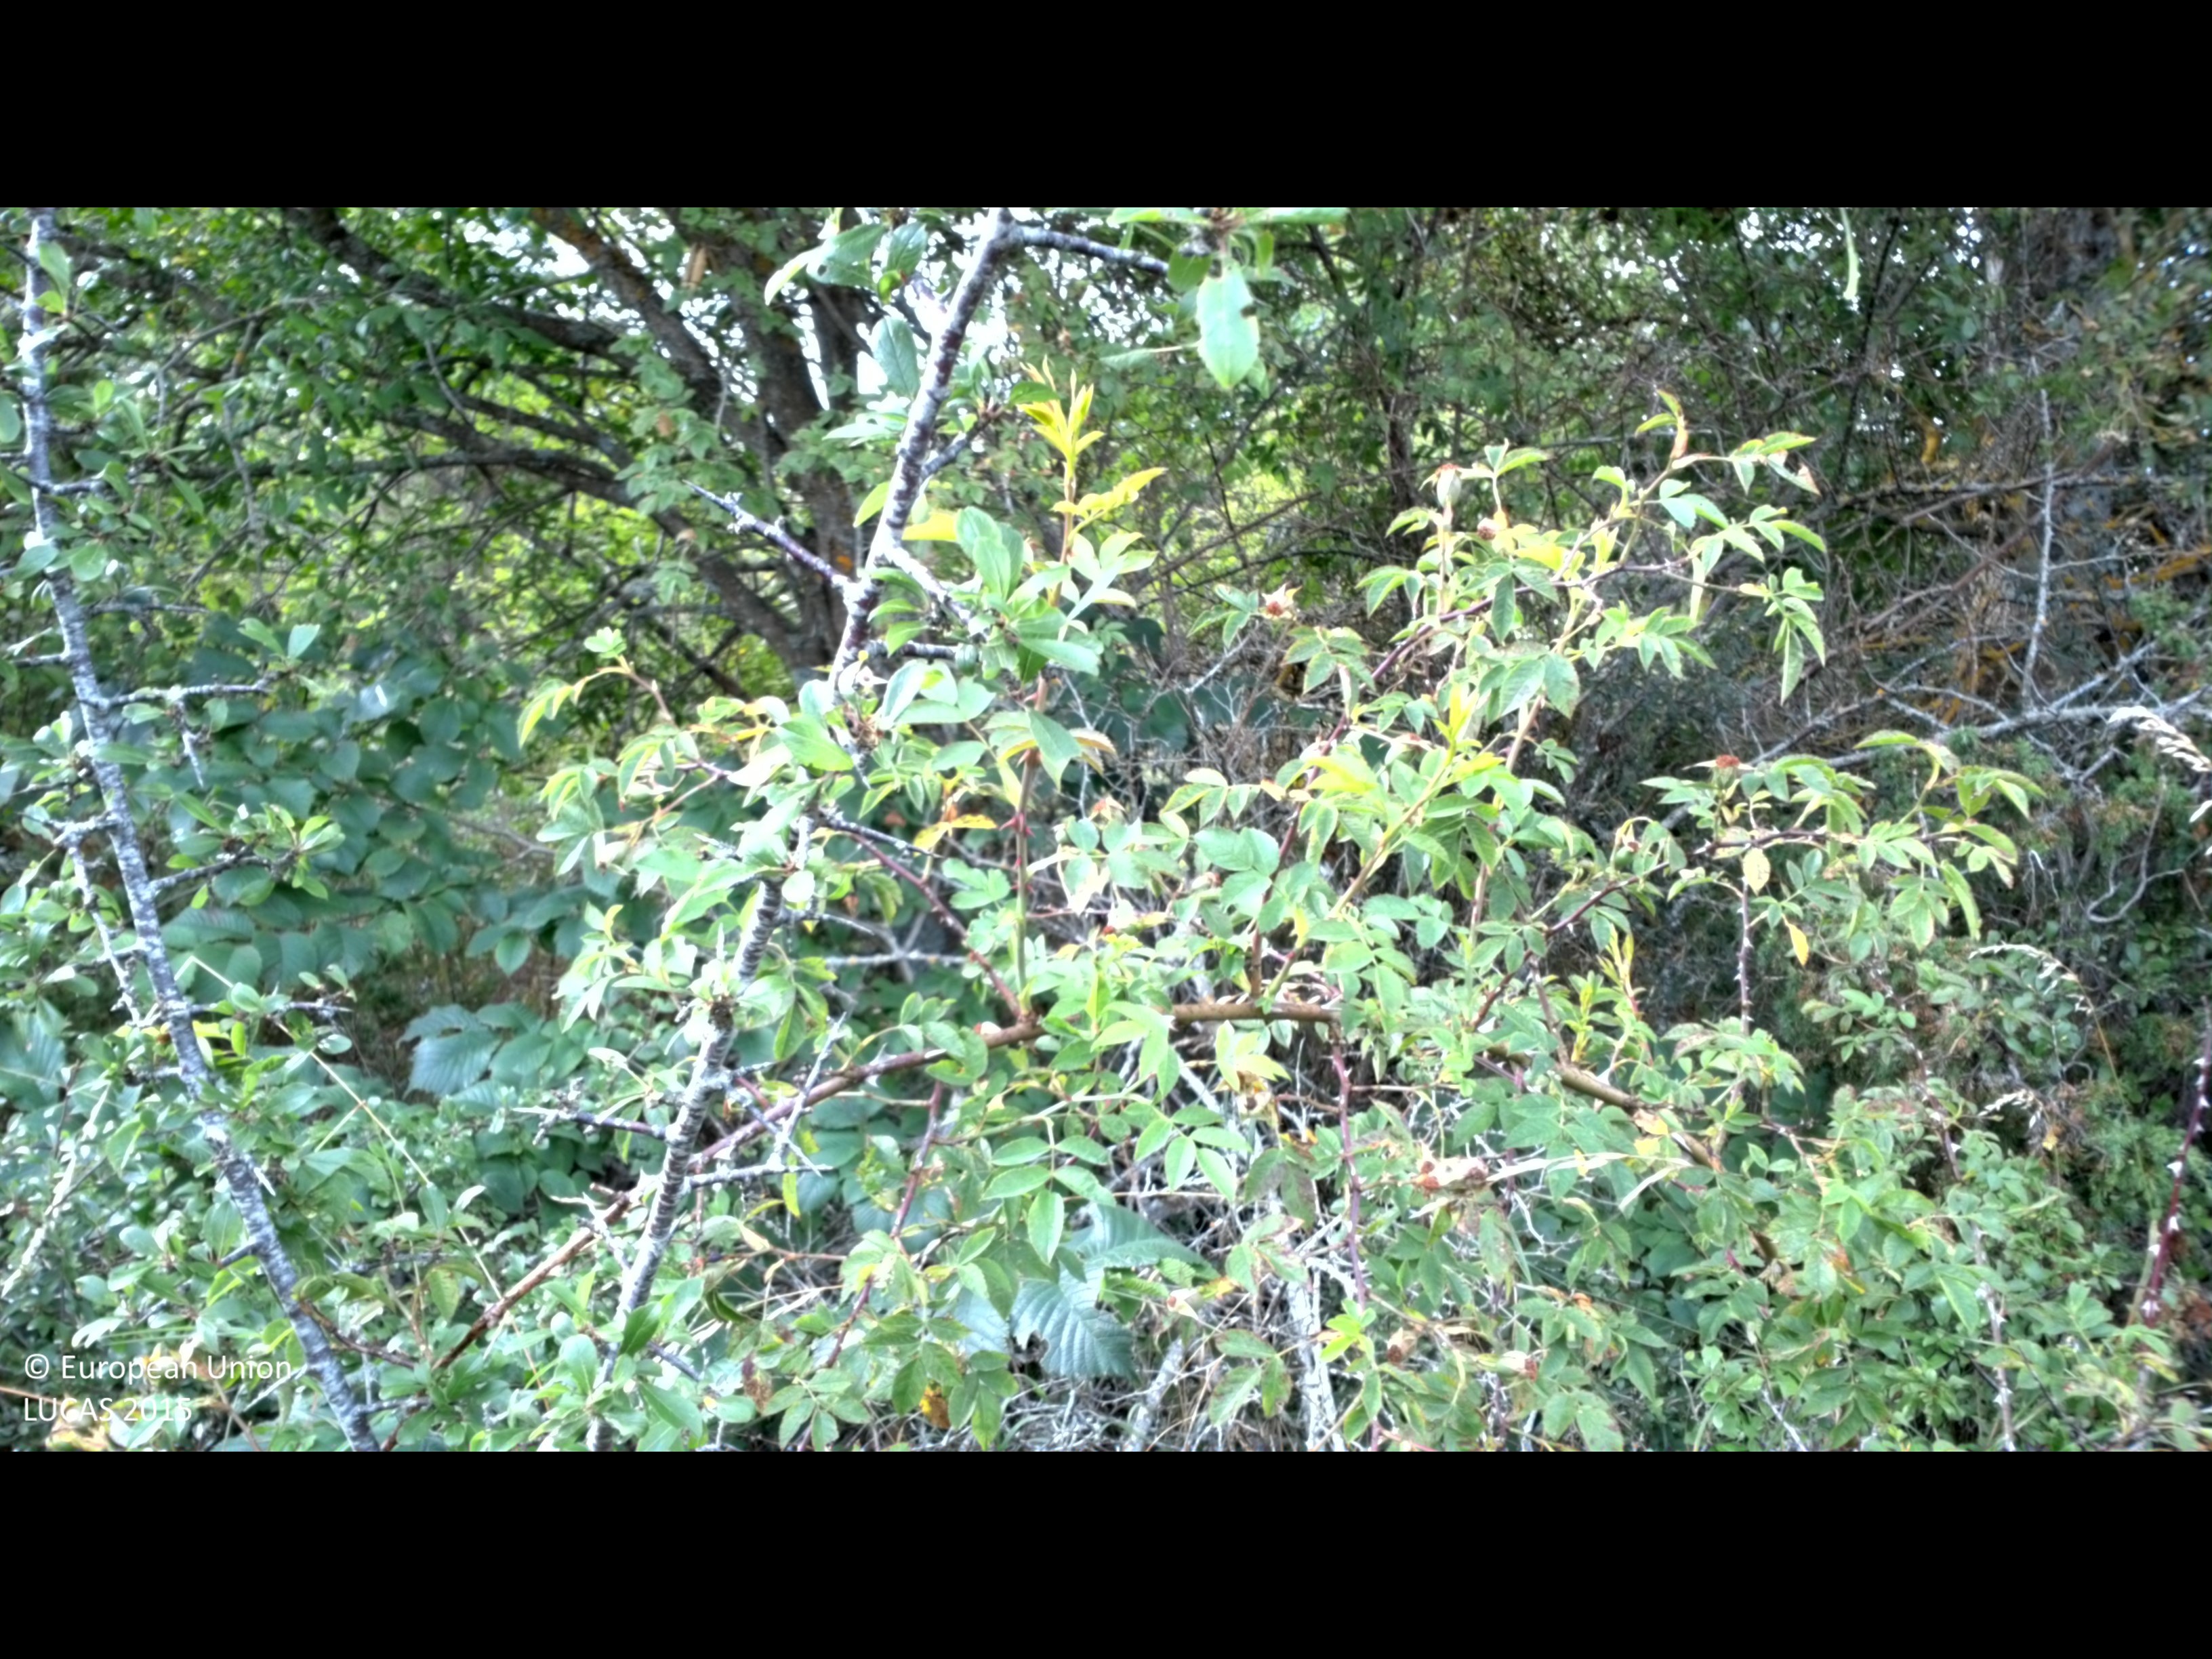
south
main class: Shrubland
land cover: Shrubland with sparse tree cover
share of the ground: > 75 %
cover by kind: shrubs 90 %, broadleaved forest trees 5 %, herbaceous plants 5 %
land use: Semi-natural and natural areas not in use
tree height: < 5 m
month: July
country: SE
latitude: 56.8459
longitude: 16.6414
